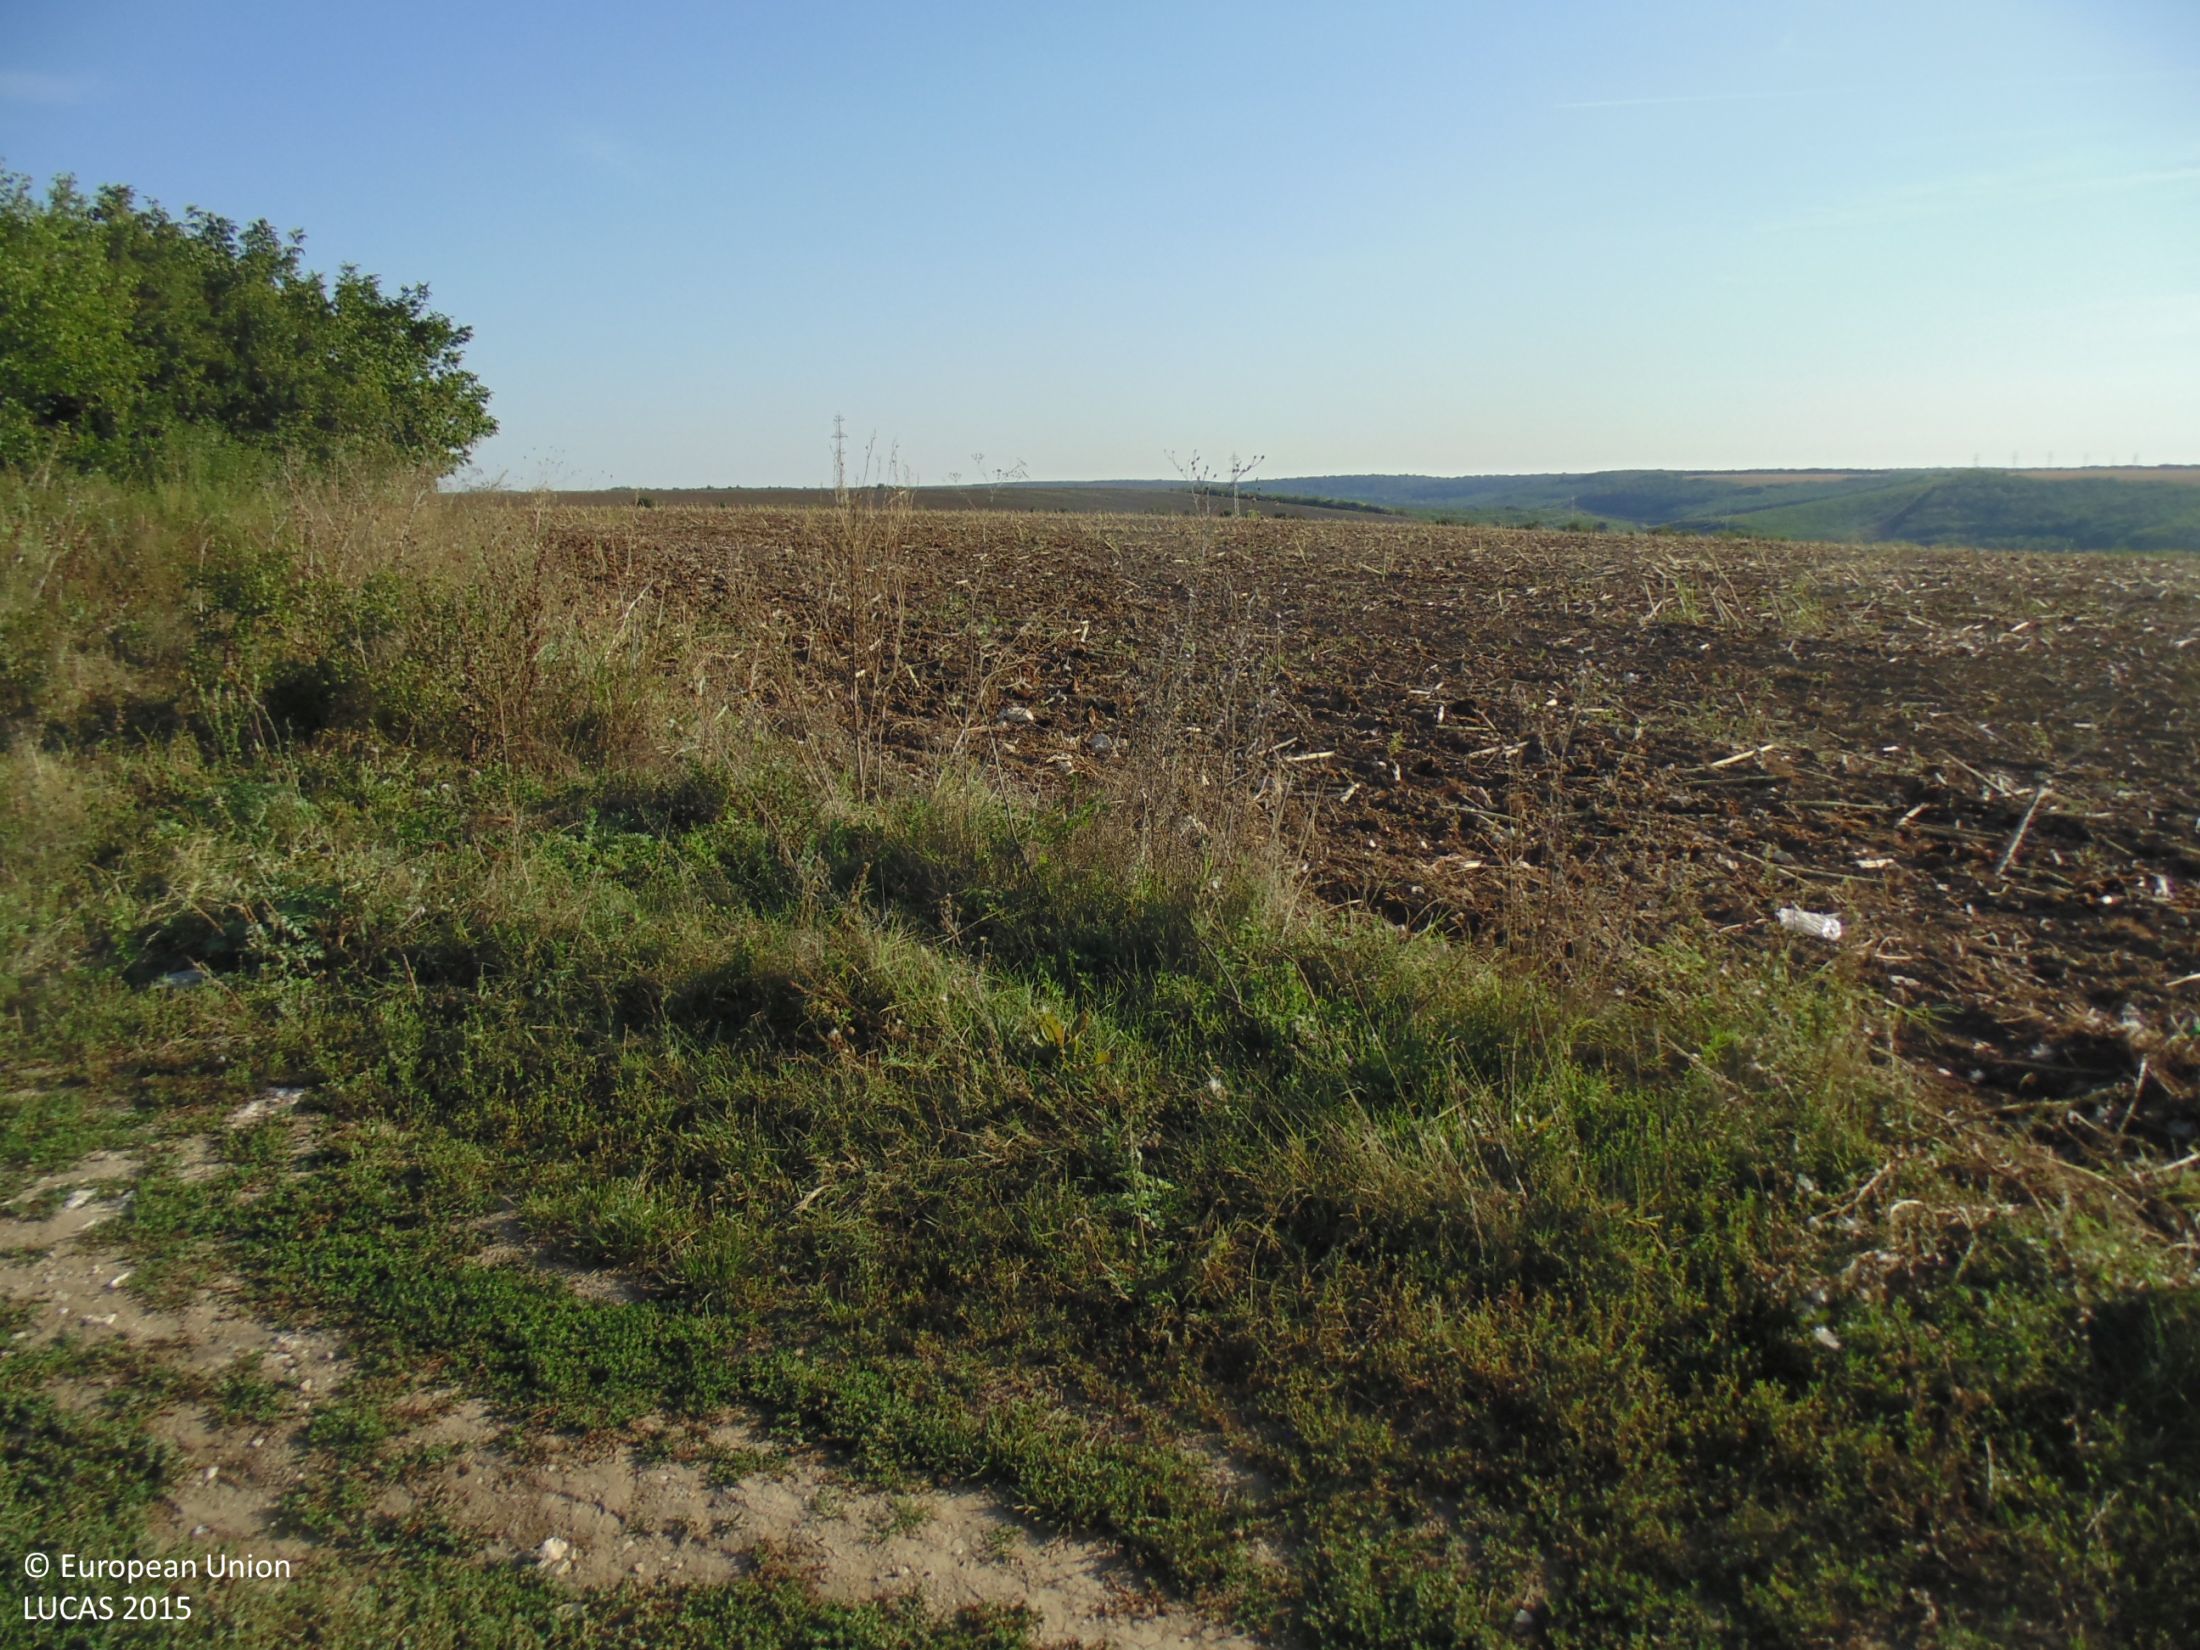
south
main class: Grassland
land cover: Grassland with sparse tree/shrub cover
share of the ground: > 75 %
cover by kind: herbaceous plants 95 %, broadleaved forest trees 5 %
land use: Semi-natural and natural areas not in use
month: September
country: BG
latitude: 44.0623
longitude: 26.8613
